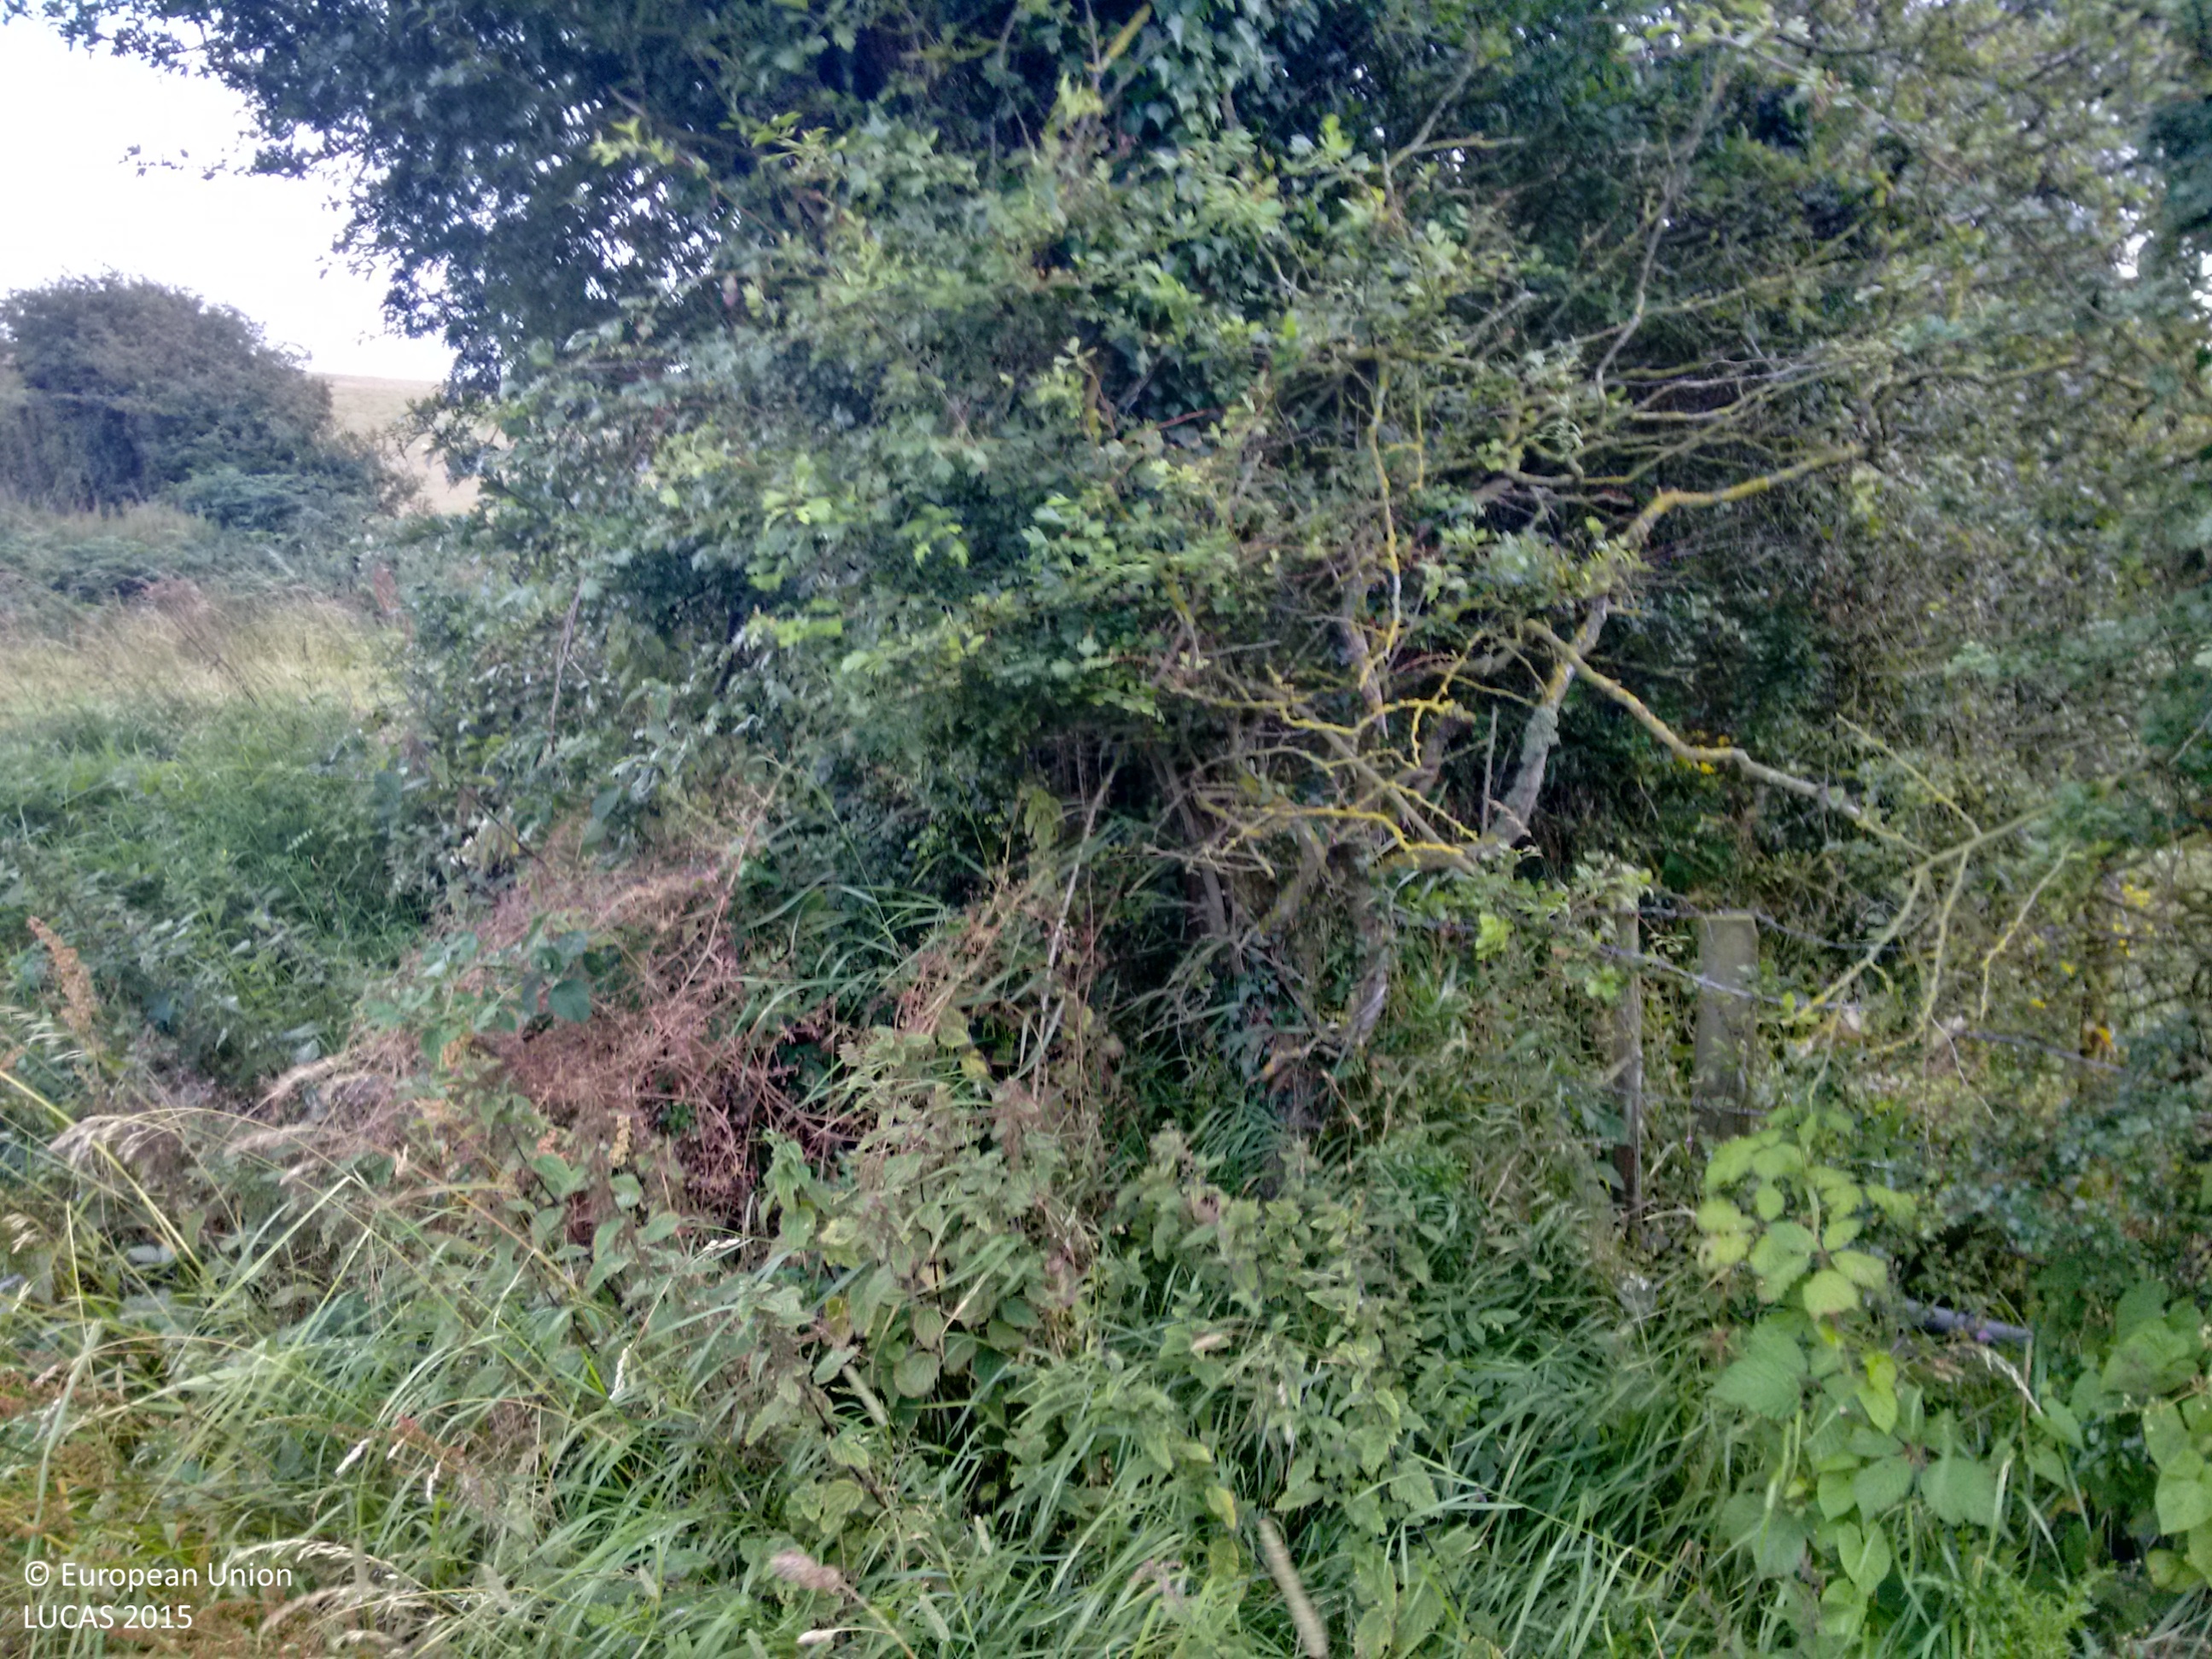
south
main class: Grassland
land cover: Grassland without tree/shrub cover
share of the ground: > 75 %
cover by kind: herbaceous plants 100 %
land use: Agriculture (excluding fallow land and kitchen gardens)
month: August
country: GB
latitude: 54.7236
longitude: -3.4802
